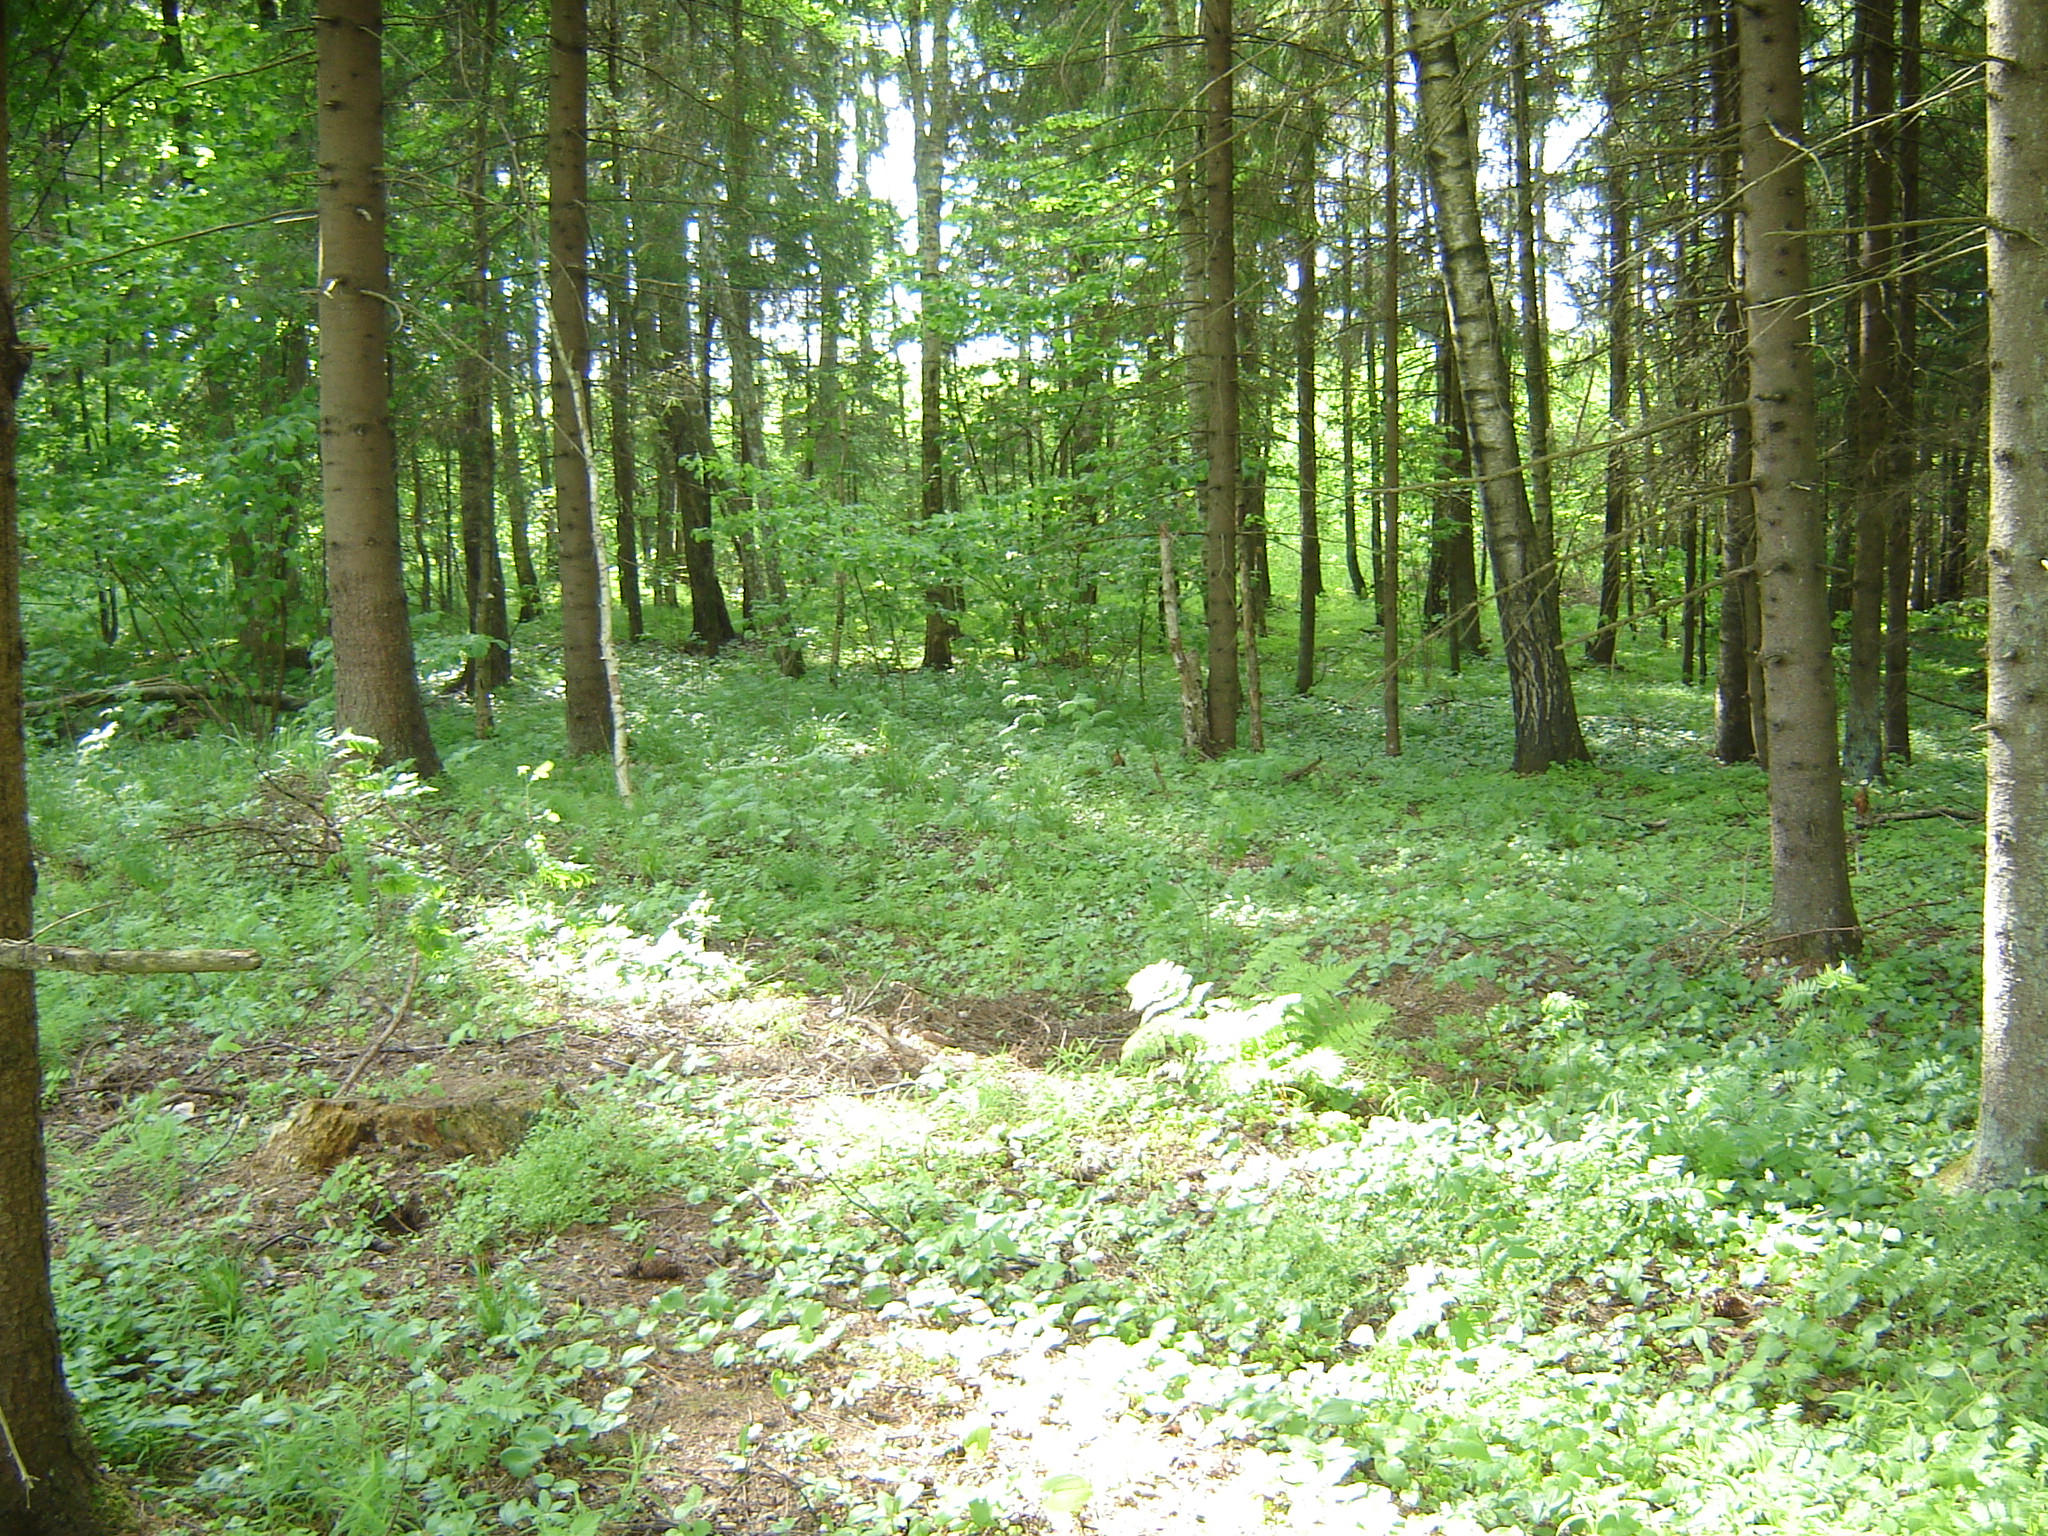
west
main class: Woodland
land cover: Spruce dominated coniferous woodland
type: hemiboreal forest and nemoral coniferous forest and mixed broadleaved-coniferous forest
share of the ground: > 75 %
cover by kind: coniferous forest trees 80 %, broadleaved forest trees 10 %, herbaceous plants 10 %
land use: Forestry
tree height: > 5 m
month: June
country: LT
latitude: 55.9083
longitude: 25.2658
